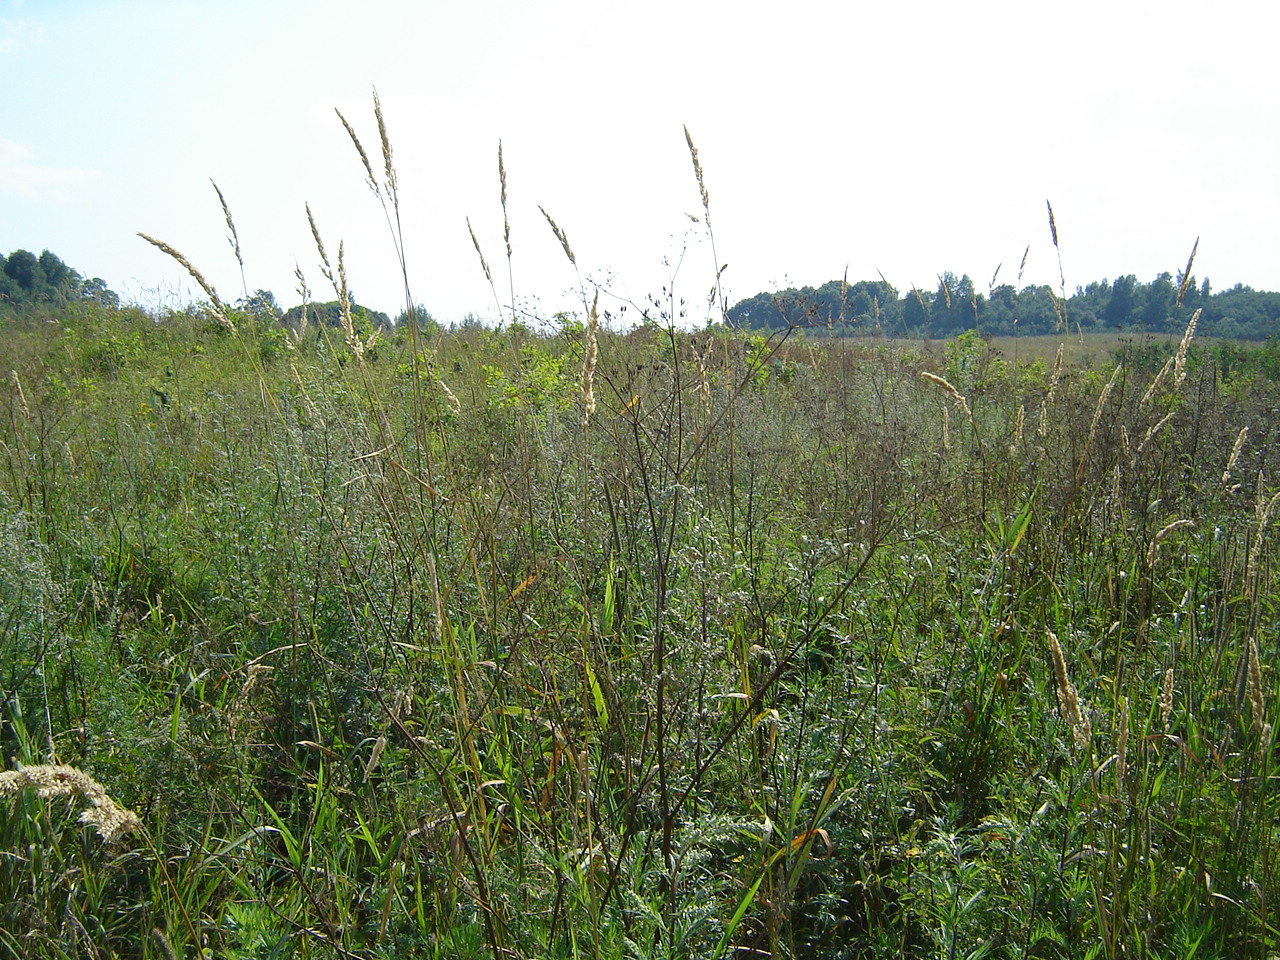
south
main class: Woodland
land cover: Broadleaved woodland
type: non-riverine alder, birch or aspen forest
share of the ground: 10 - 25 %
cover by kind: herbaceous plants 85 %, broadleaved forest trees 15 %
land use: Forestry
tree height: < 5 m
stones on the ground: < 10 %
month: August
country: LT
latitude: 55.1550
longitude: 25.4249
